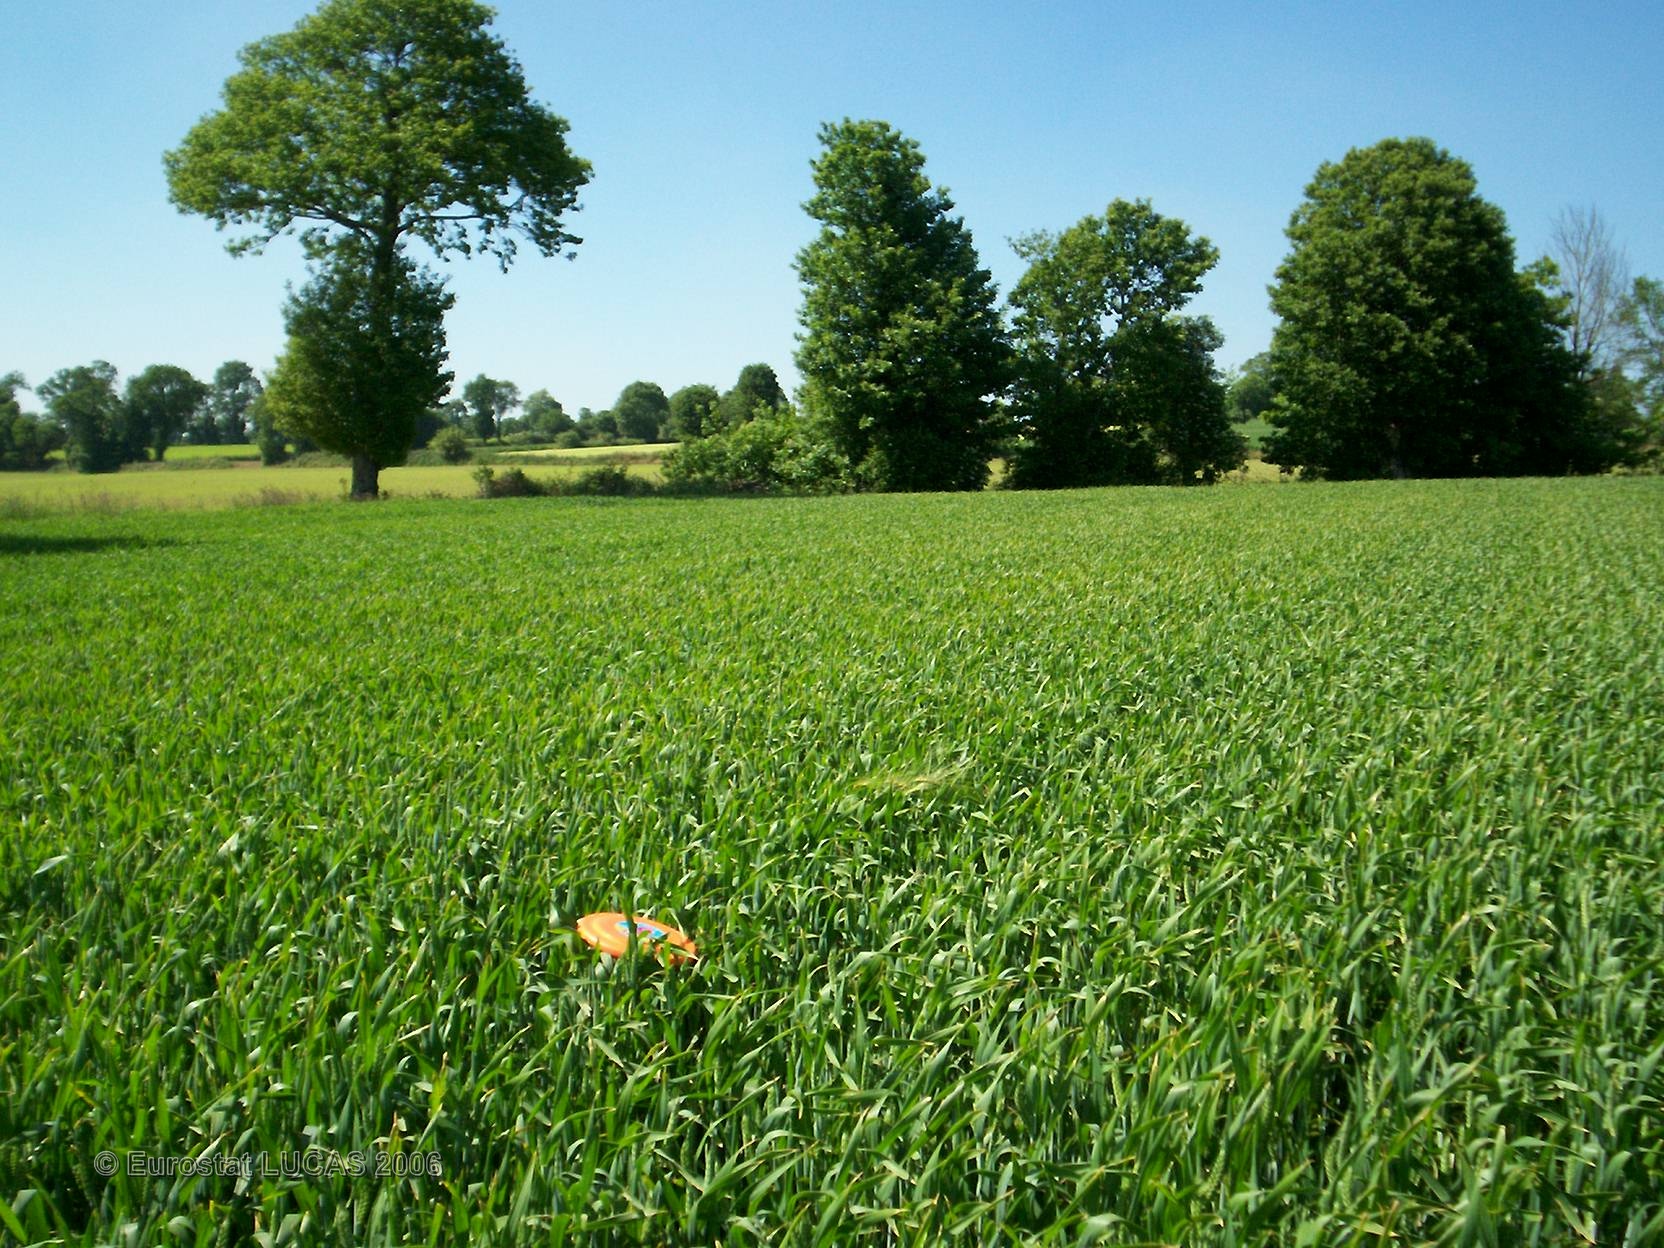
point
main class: Cropland
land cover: Common wheat
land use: Agriculture (excluding fallow land and kitchen gardens)
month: June
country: FR
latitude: 48.4180
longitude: -1.6830
